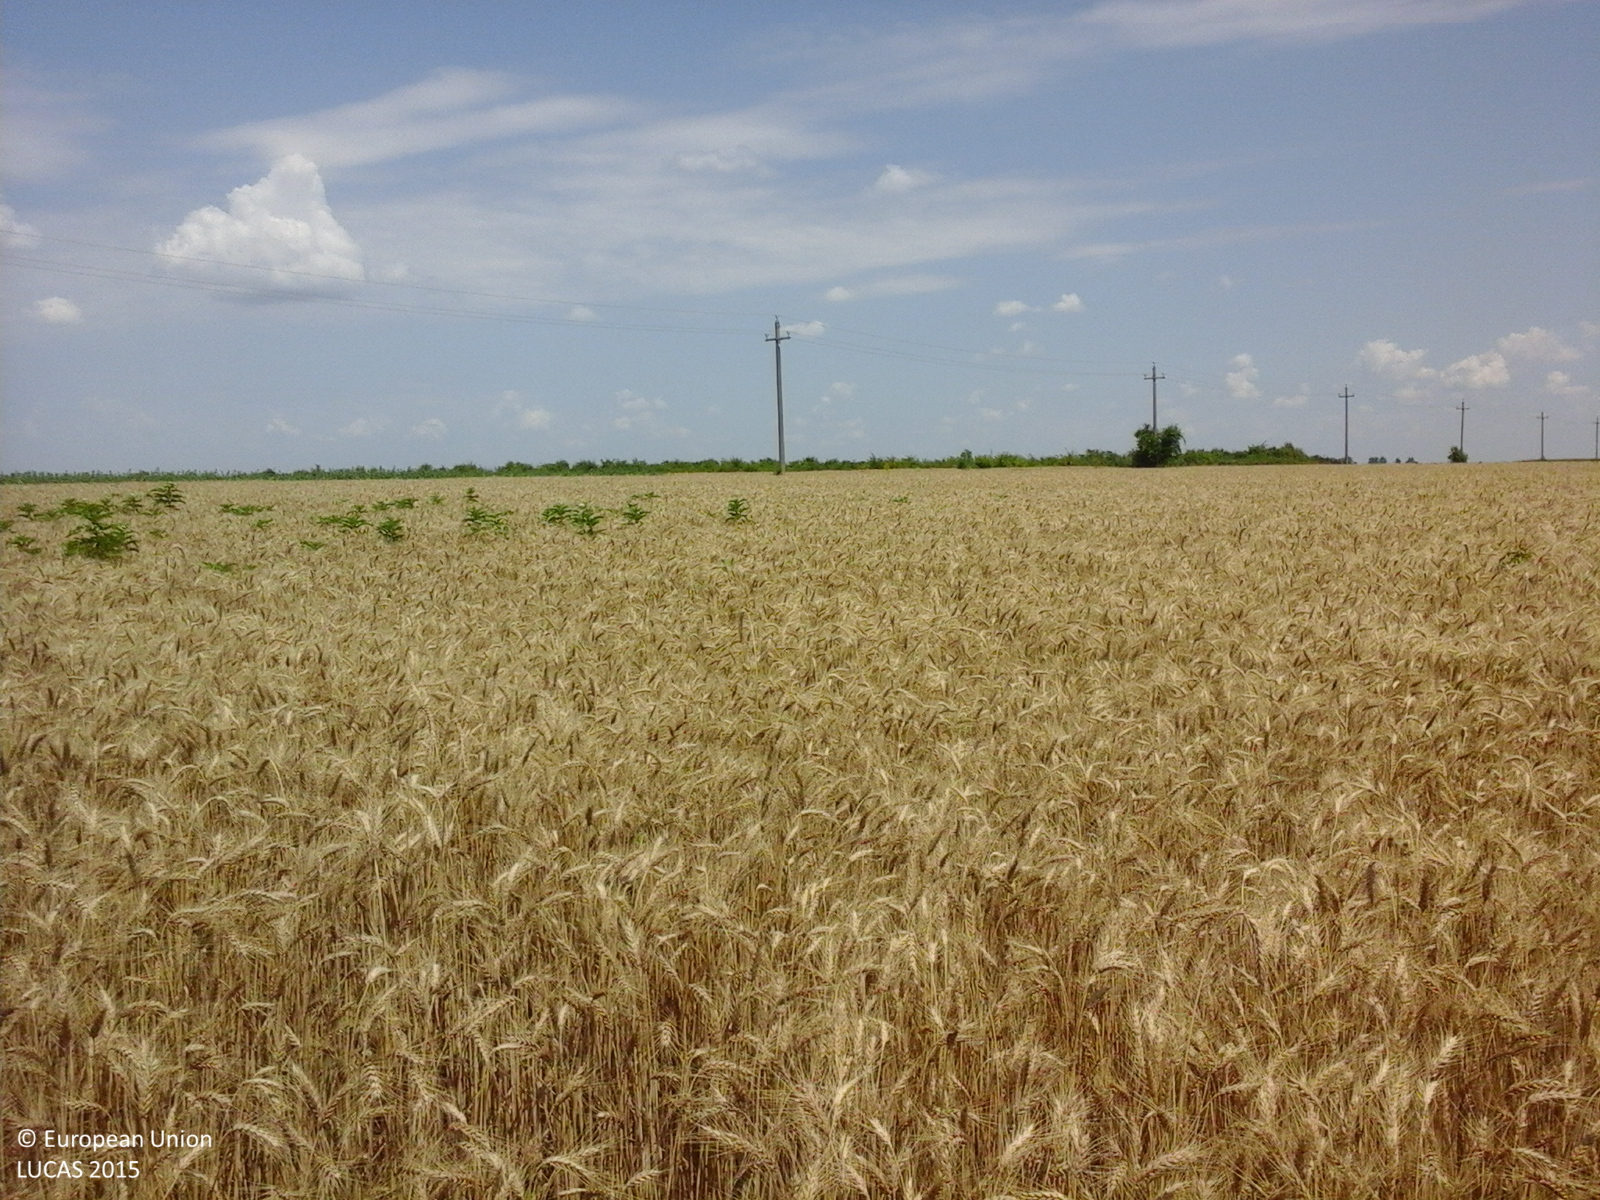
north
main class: Cropland
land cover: Common wheat
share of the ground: > 75 %
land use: Agriculture (excluding fallow land and kitchen gardens)
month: June
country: RO
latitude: 44.1244
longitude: 26.3670
